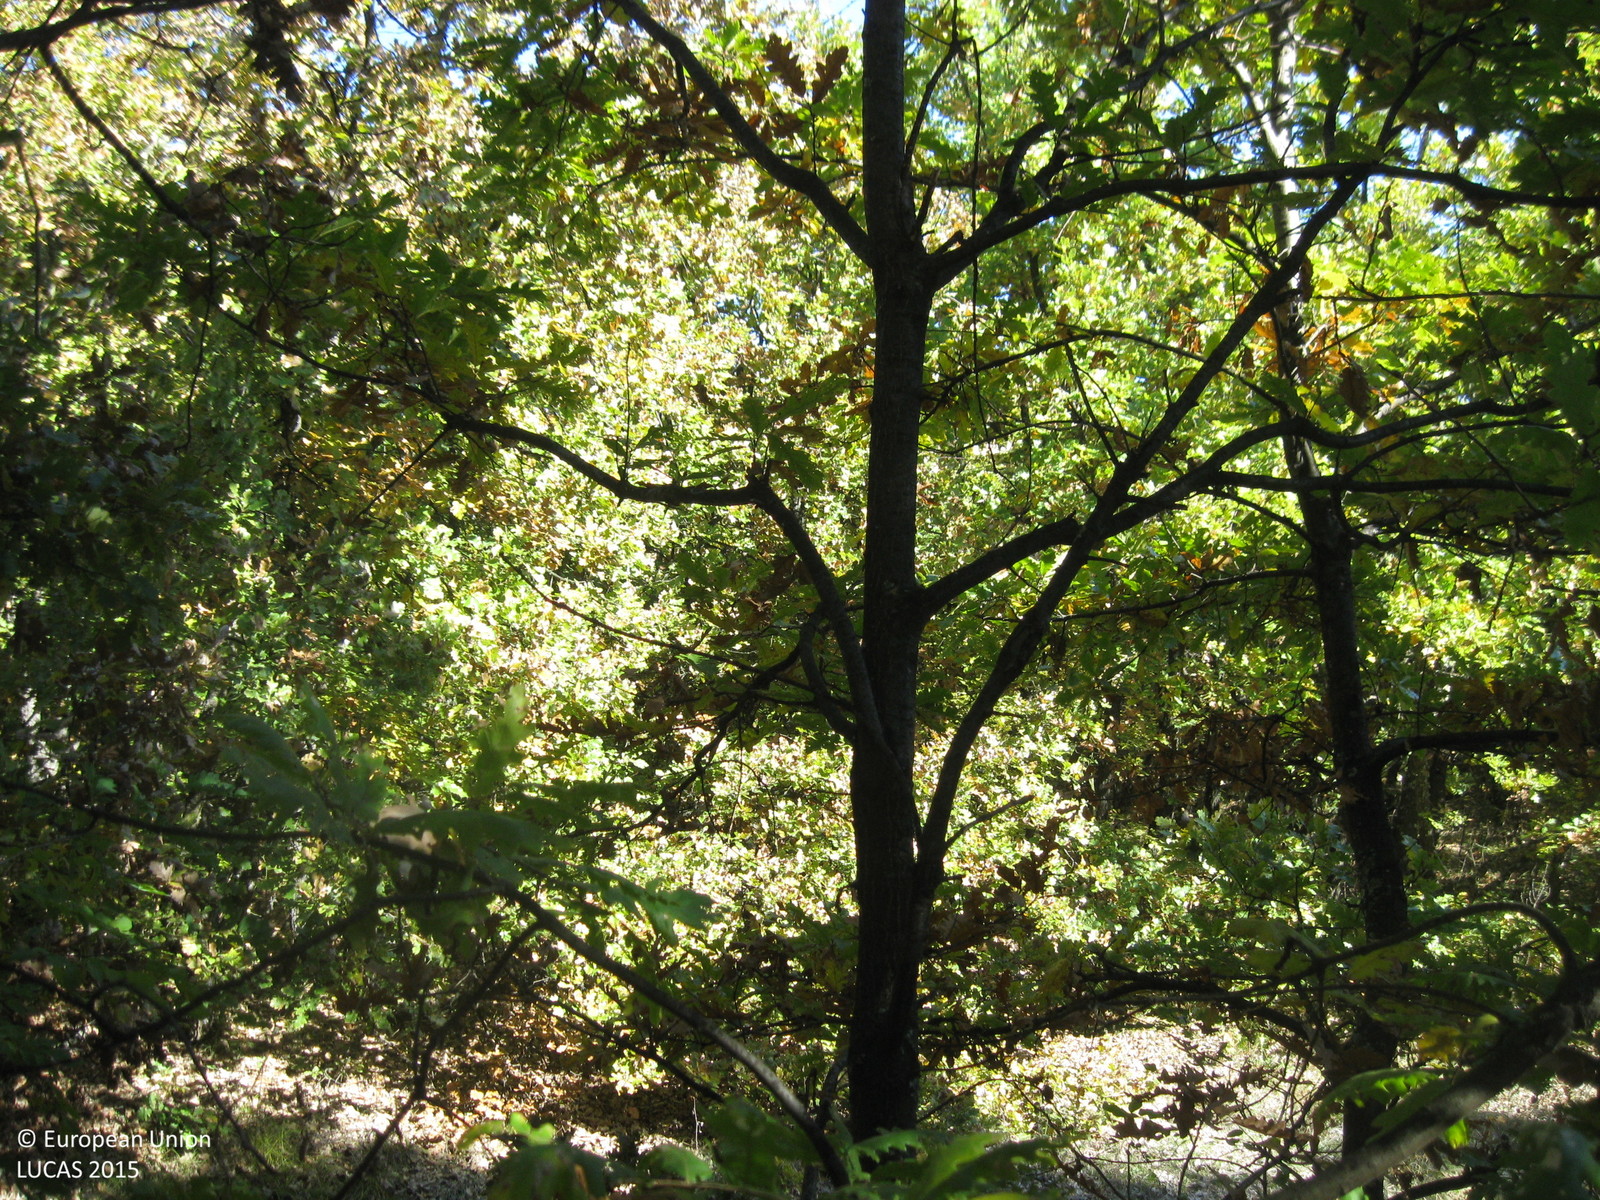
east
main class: Woodland
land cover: Broadleaved woodland
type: thermophilous deciduous forest
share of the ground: > 75 %
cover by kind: broadleaved forest trees 90 %, shrubs 5 %, herbaceous plants 5 %
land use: Forestry
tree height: > 5 m
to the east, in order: Broadleaved woodland; Tracks; Broadleaved woodland; Tracks; Broadleaved woodland
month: November
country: BG
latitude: 42.3531
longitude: 24.2614
